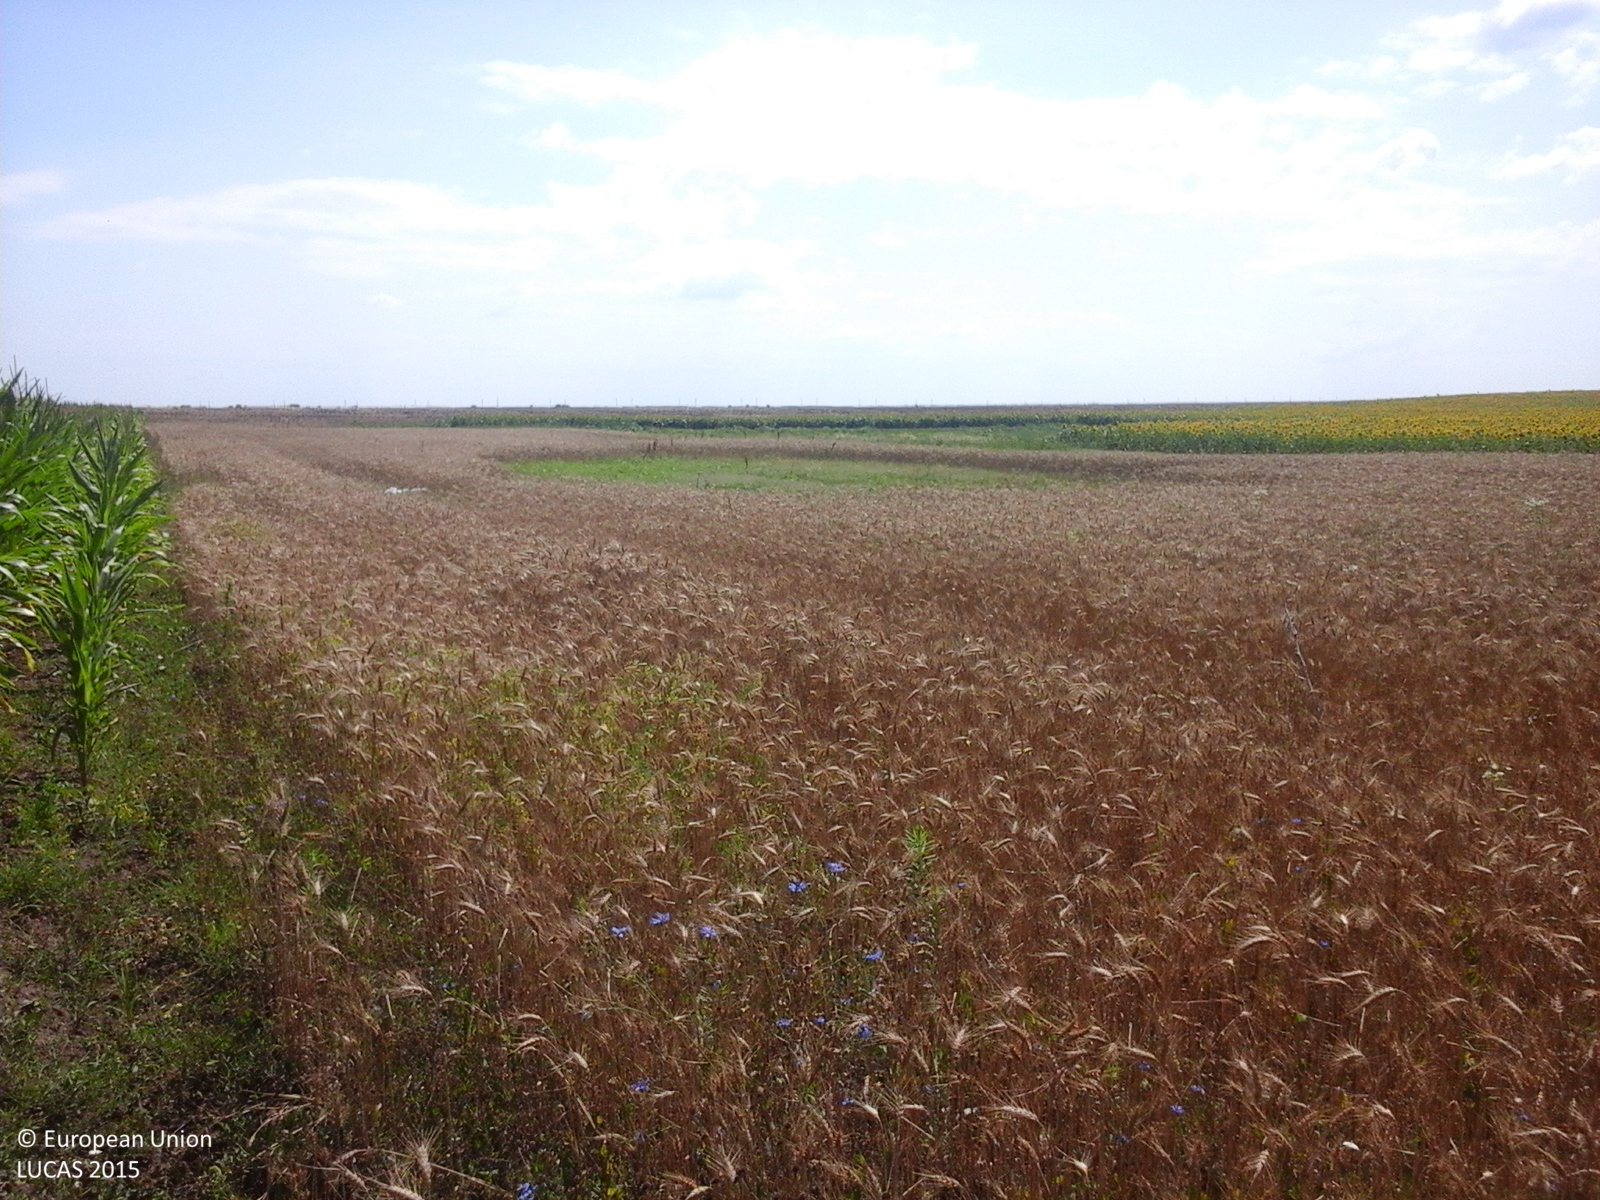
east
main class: Cropland
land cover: Maize
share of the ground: > 75 %
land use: Agriculture (excluding fallow land and kitchen gardens)
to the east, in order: Maize; Grass margins; Tracks; Grass margins; Rape and turnip rape
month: July
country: RO
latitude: 43.8943
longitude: 24.7473
